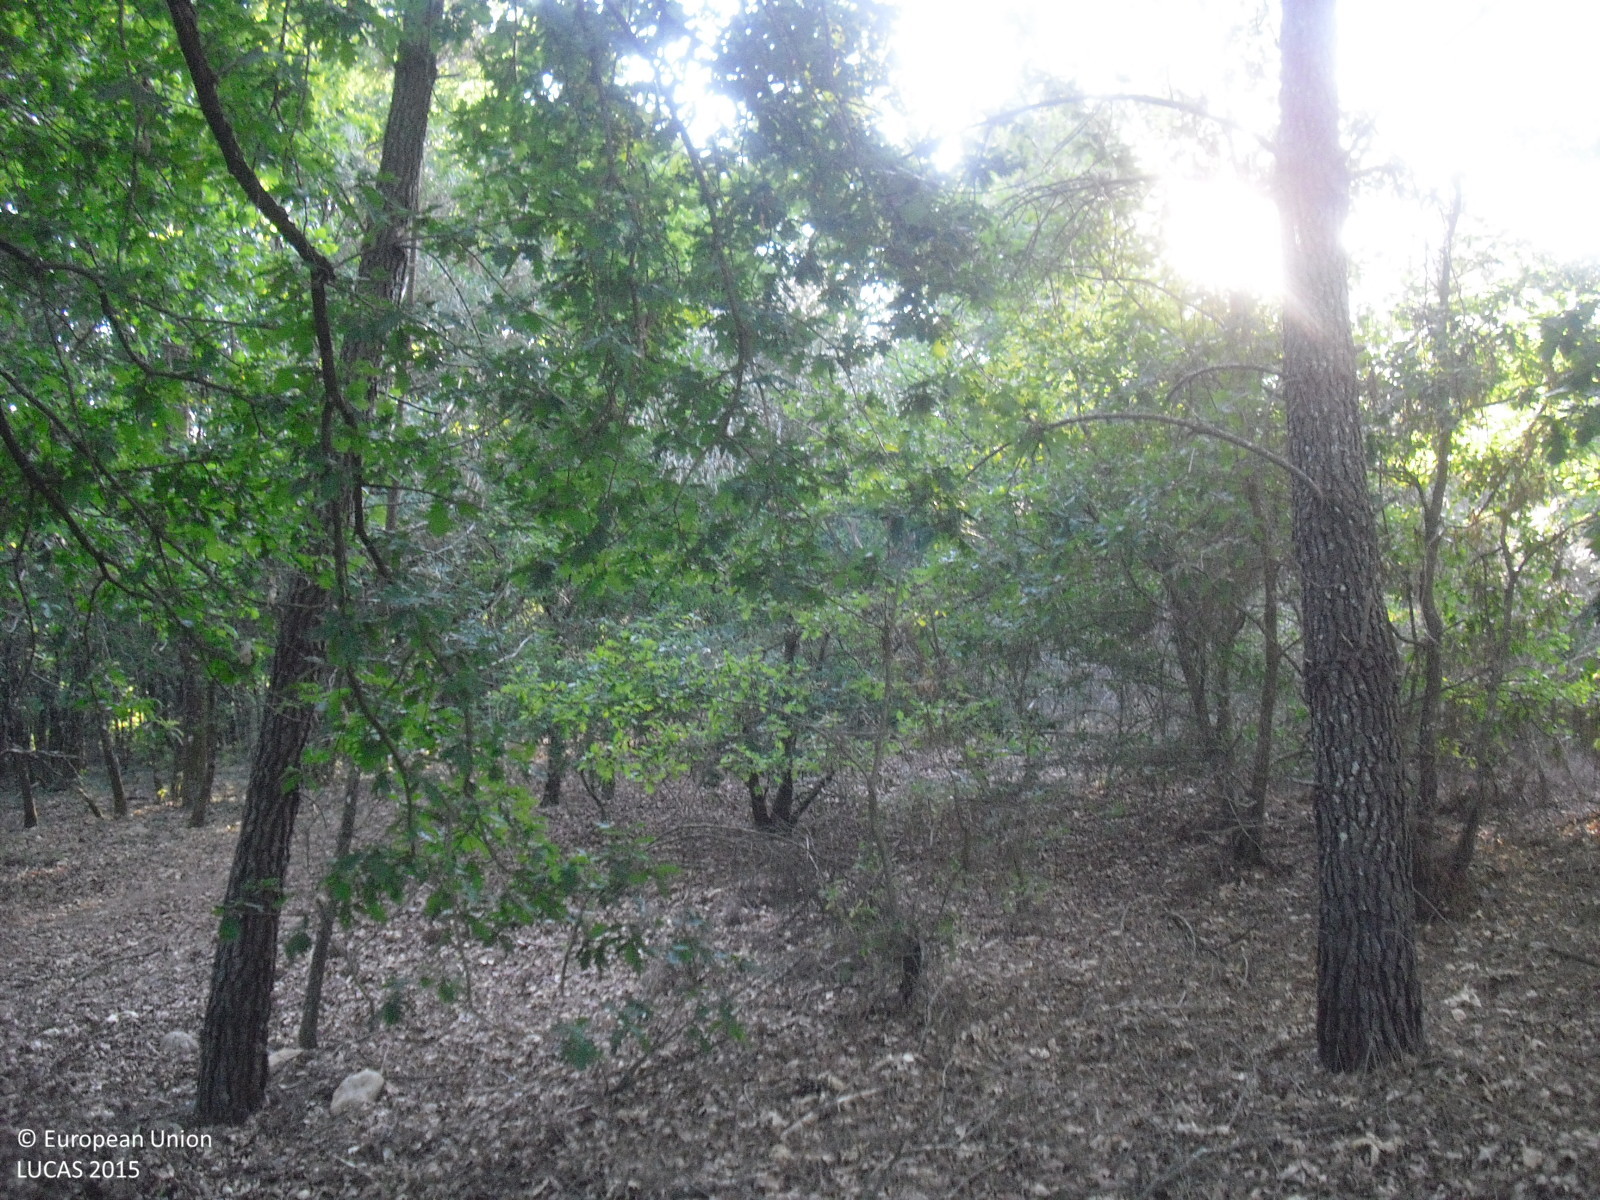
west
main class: Woodland
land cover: Pine dominated mixed woodland
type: hemiboreal forest and nemoral coniferous forest and mixed broadleaved-coniferous forest
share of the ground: > 75 %
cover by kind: coniferous forest trees 60 %, broadleaved forest trees 30 %, shrubs 10 %
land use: Forestry
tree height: > 5 m
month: July
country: ES
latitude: 42.6114
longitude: -7.4901
